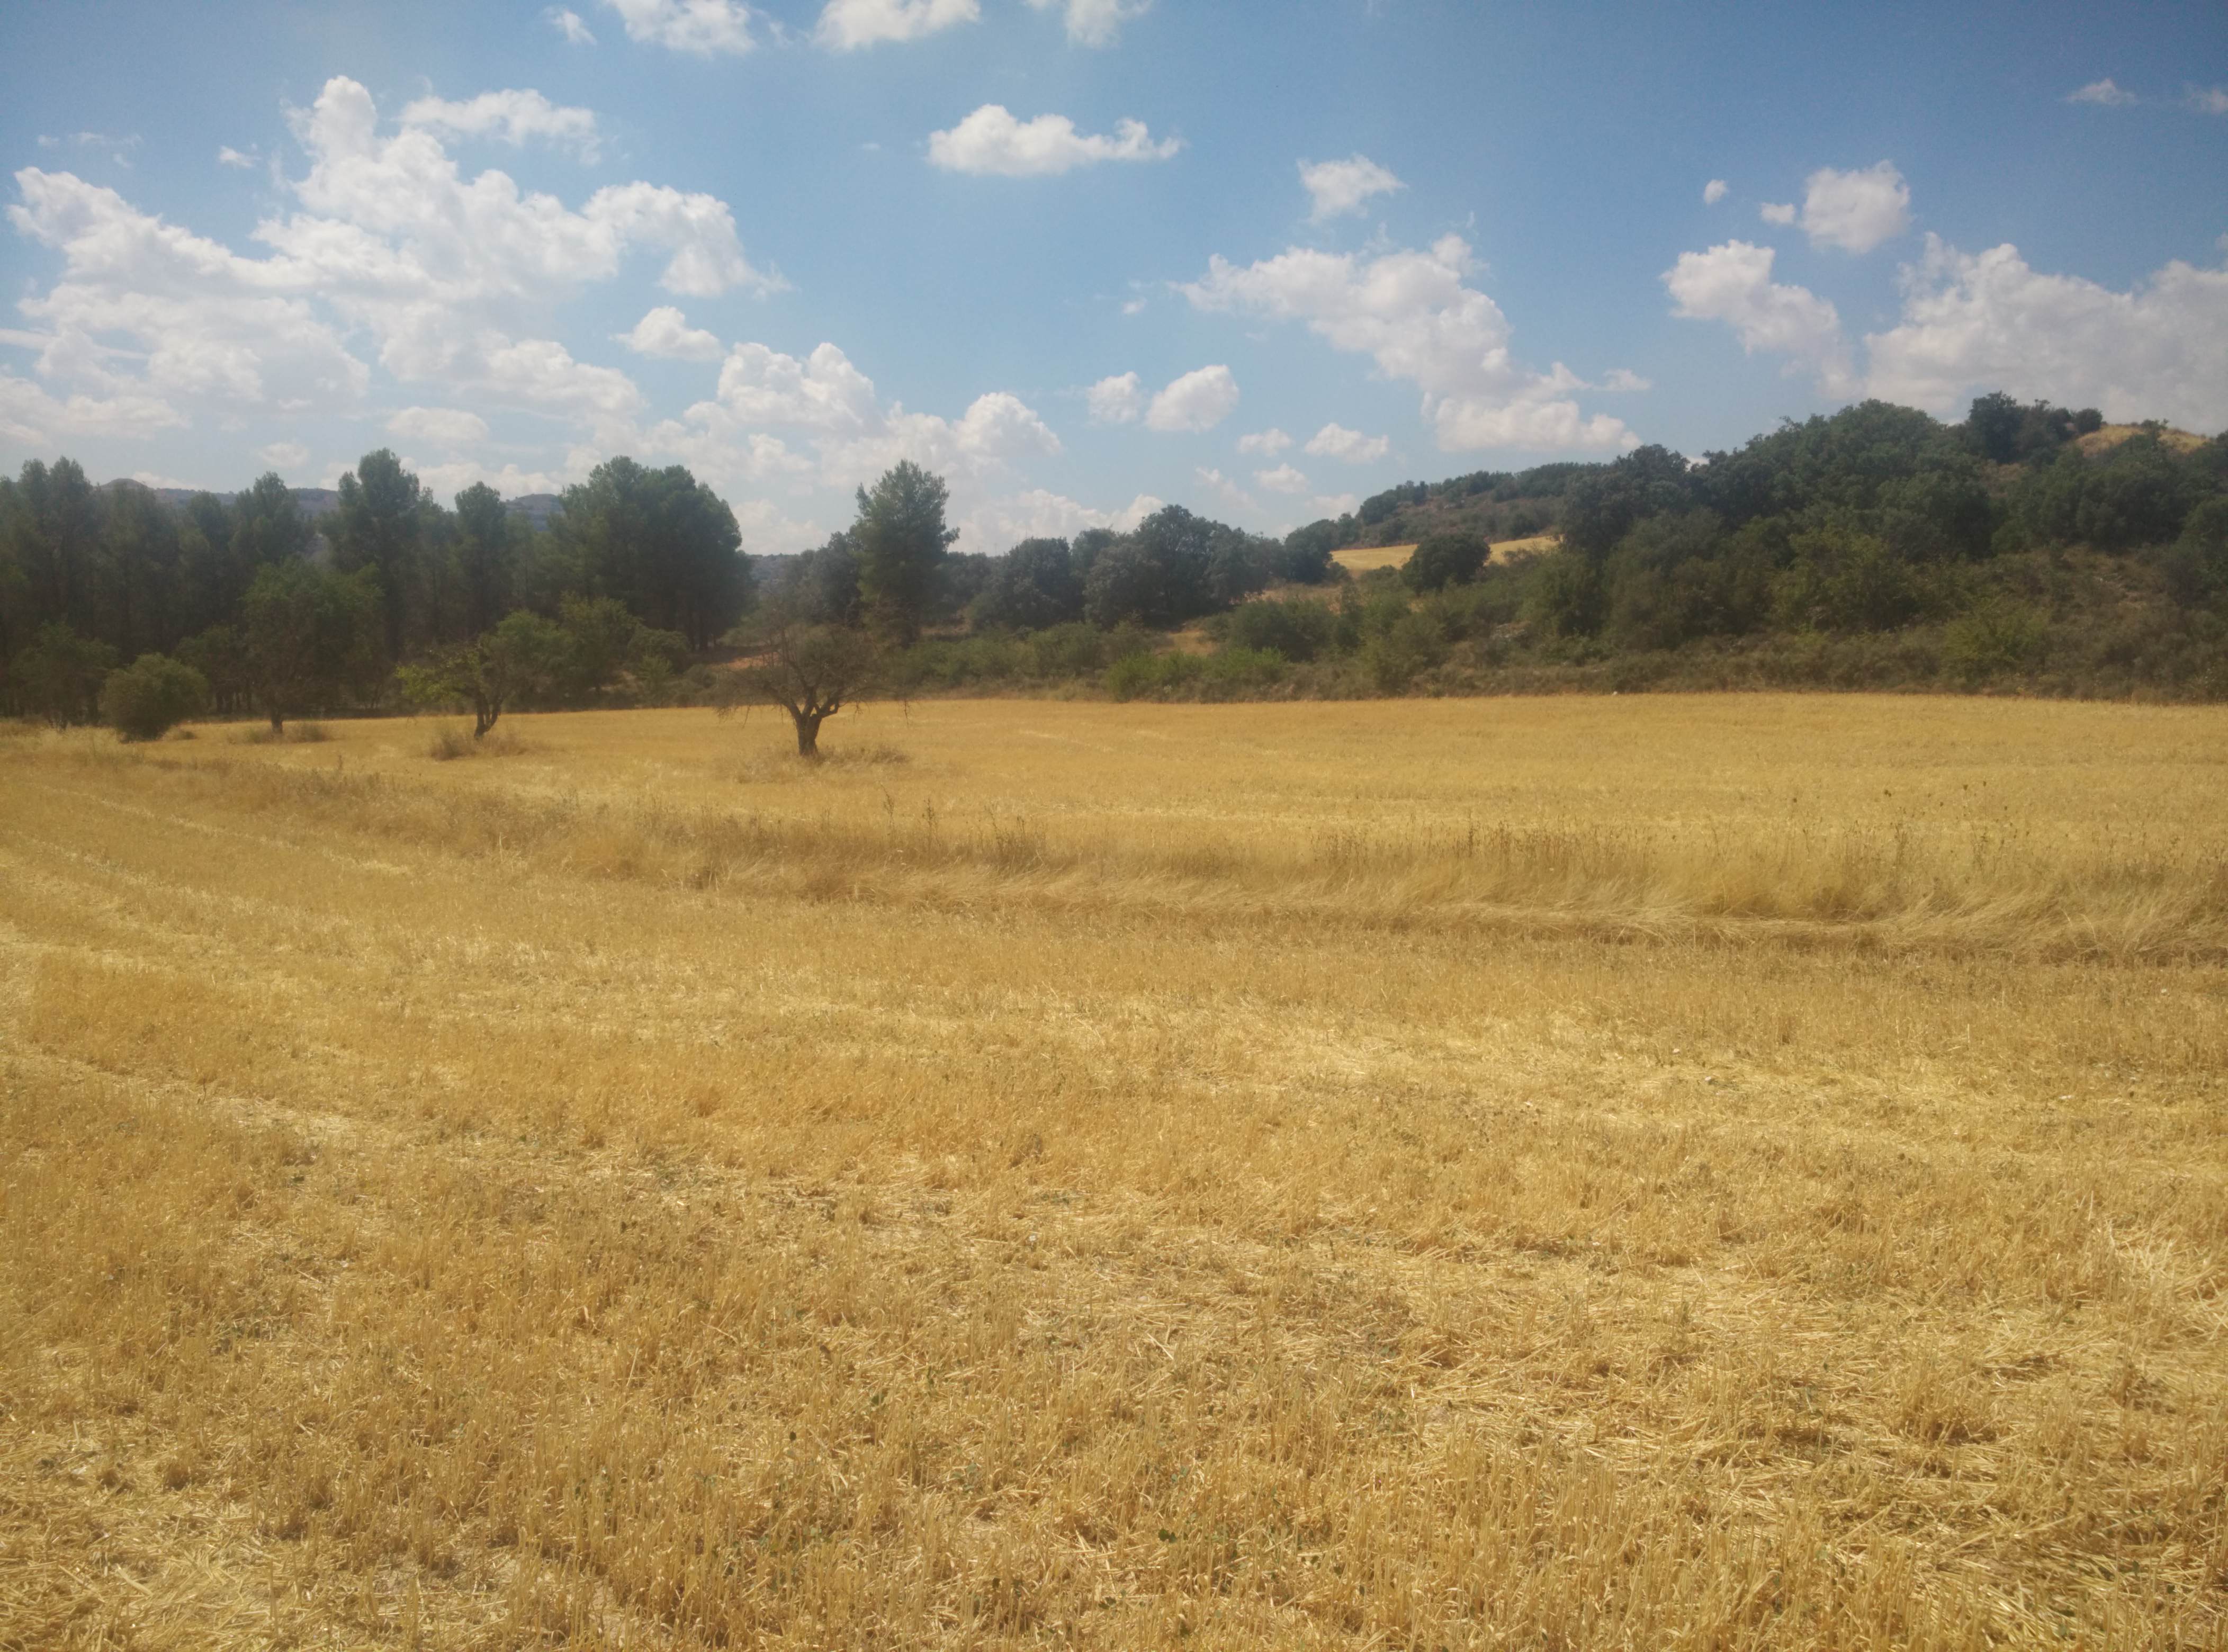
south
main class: Cropland
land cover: Barley
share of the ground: < 10 %
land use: Agriculture (excluding fallow land and kitchen gardens)
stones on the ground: 25 - 50 %
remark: Harvested field
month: July
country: ES
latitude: 40.4532
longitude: -2.6303
